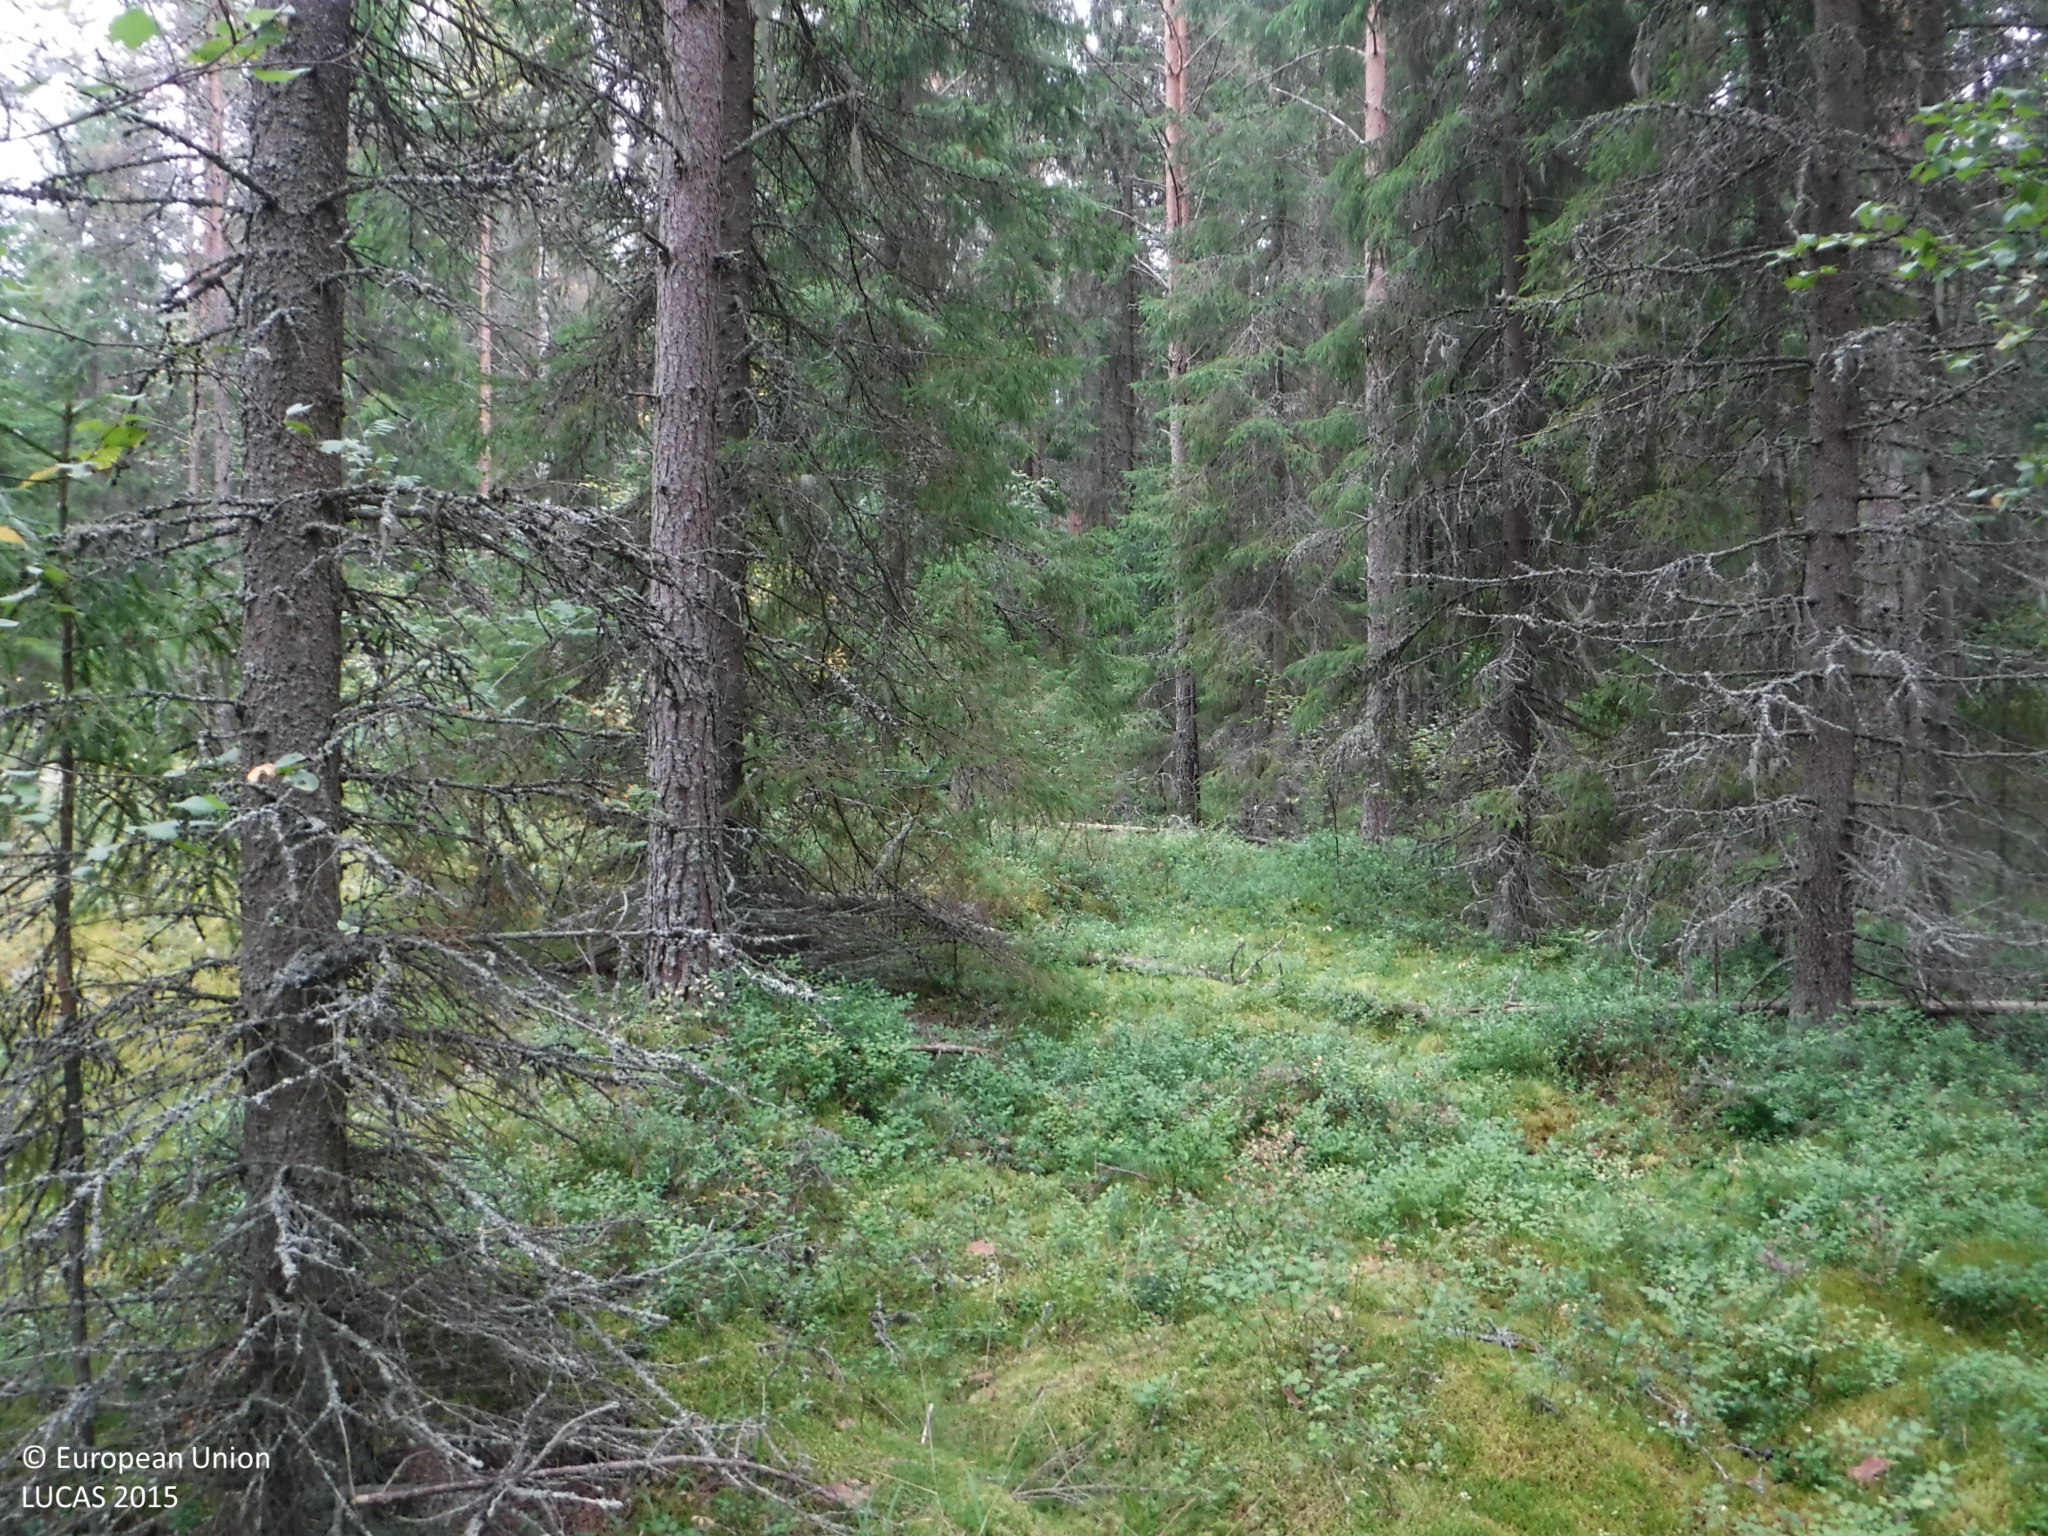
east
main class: Woodland
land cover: Other coniferous woodland
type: boreal forest
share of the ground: 50 - 75 %
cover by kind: coniferous forest trees 50 %, lichens and mosses 25 %, shrubs 20 %, herbaceous plants 5 %
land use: Forestry
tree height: > 5 m
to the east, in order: Other coniferous woodland; Tracks; Ditches and canals; Other coniferous woodland; Other mixed woodland; Other coniferous woodland; Spruce dominated coniferous woodland
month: September
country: FI
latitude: 61.2508
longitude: 21.5900
